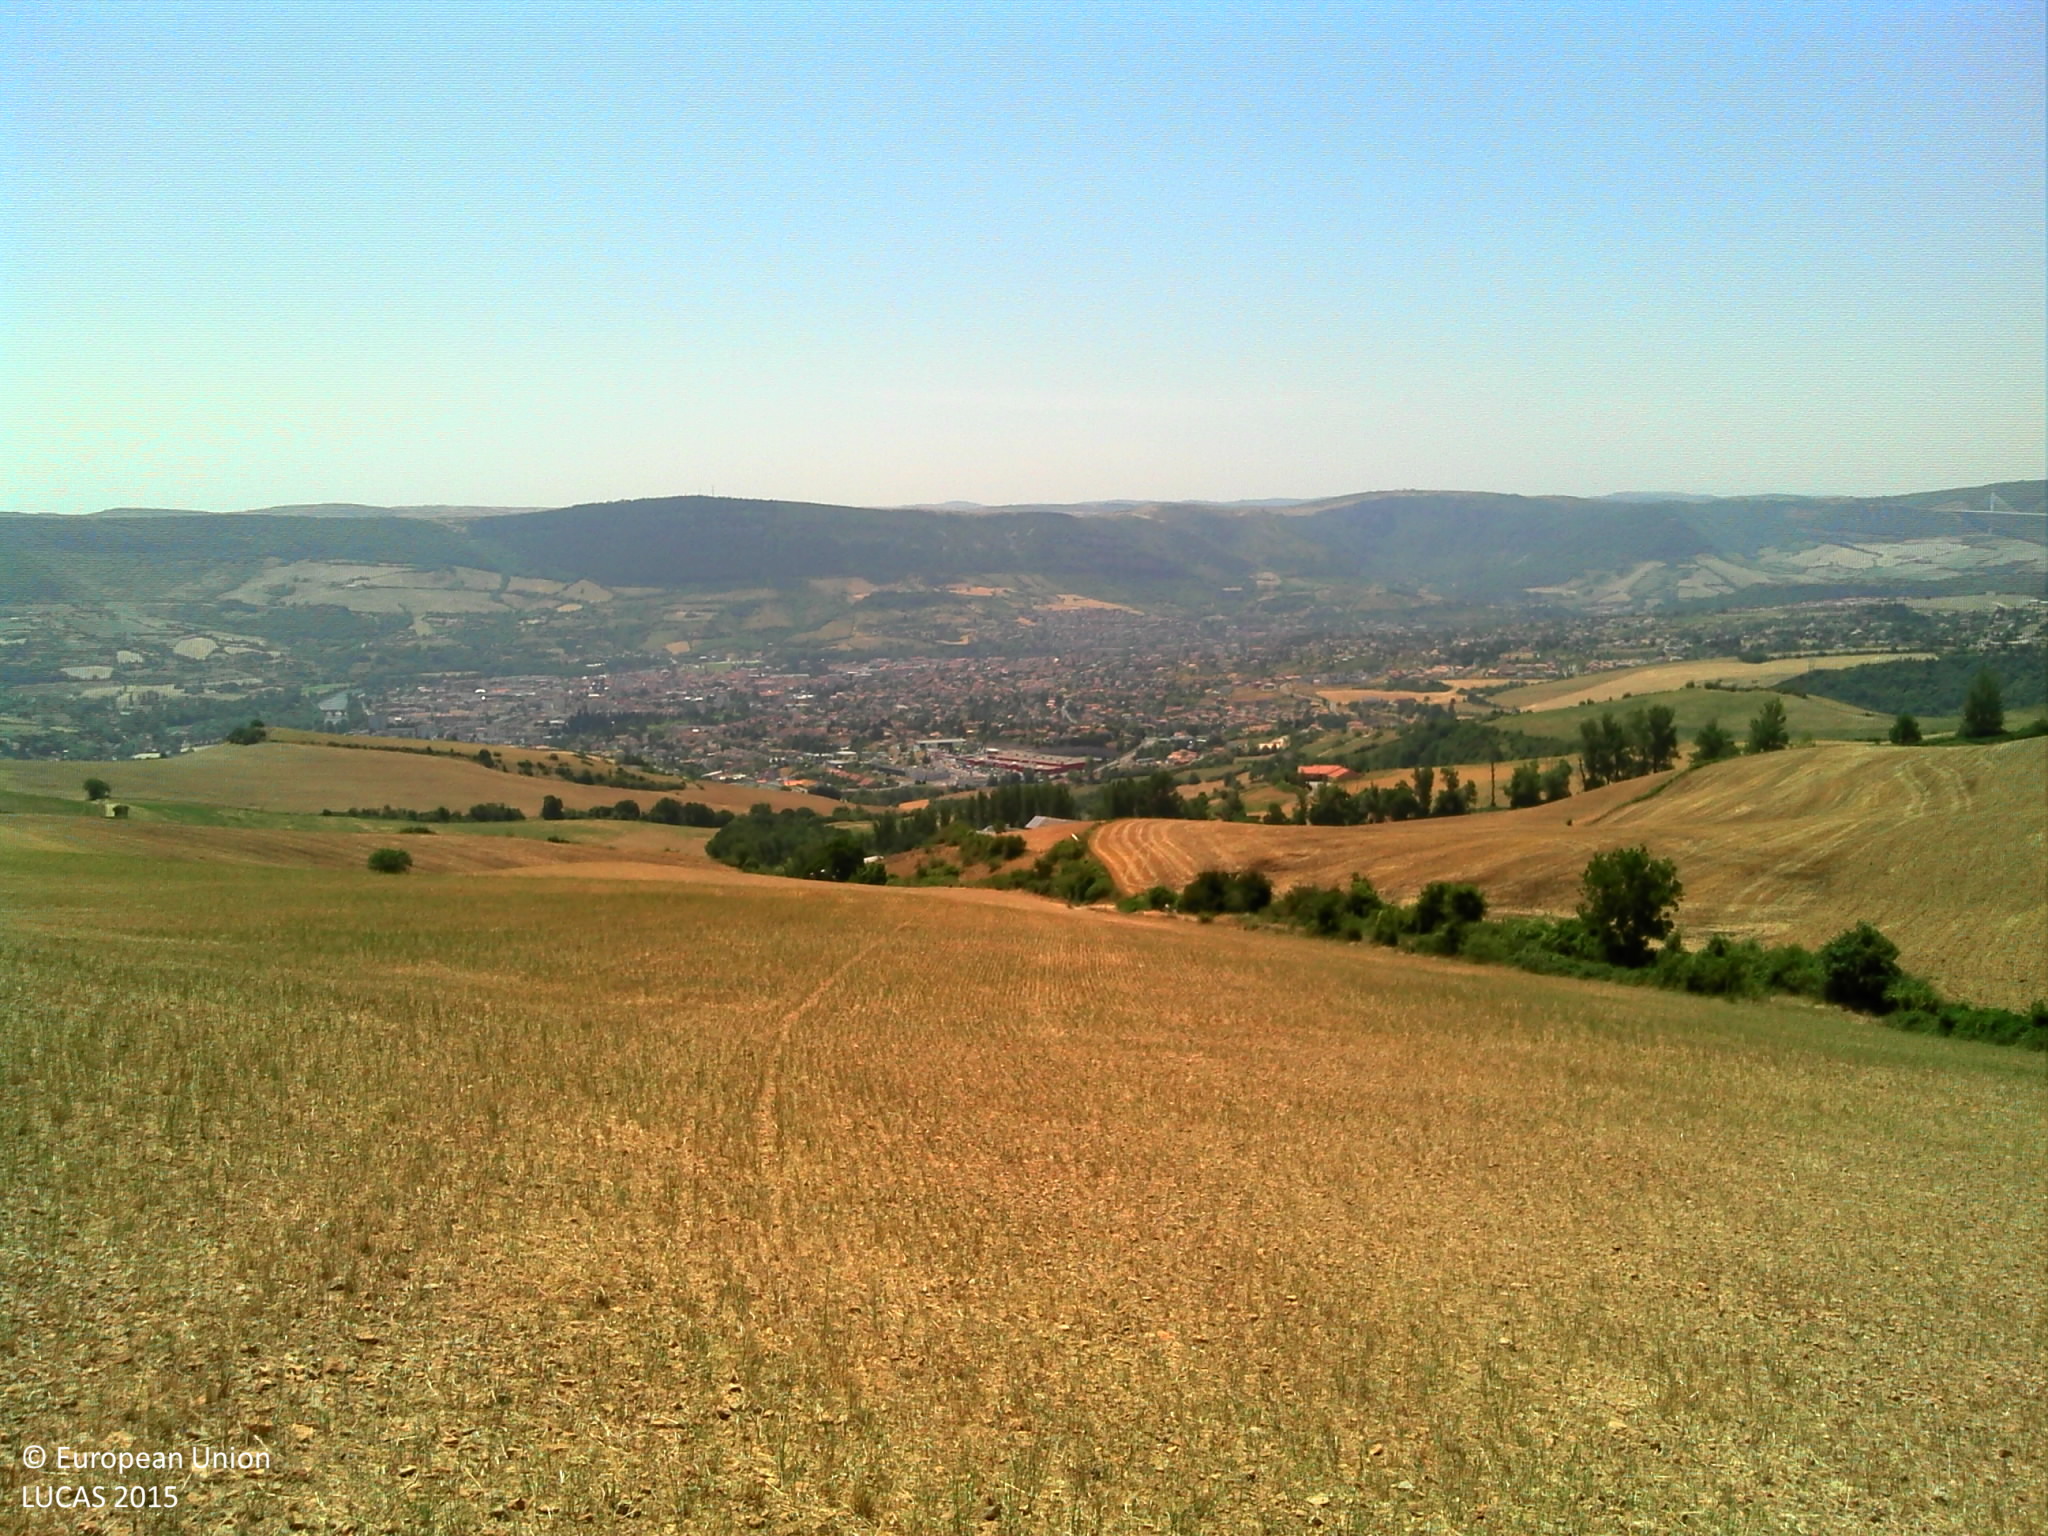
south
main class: Cropland
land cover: Temporary grasslands
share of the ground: 25 - 50 %
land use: Agriculture (excluding fallow land and kitchen gardens)
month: July
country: FR
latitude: 44.1367
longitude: 3.0684
